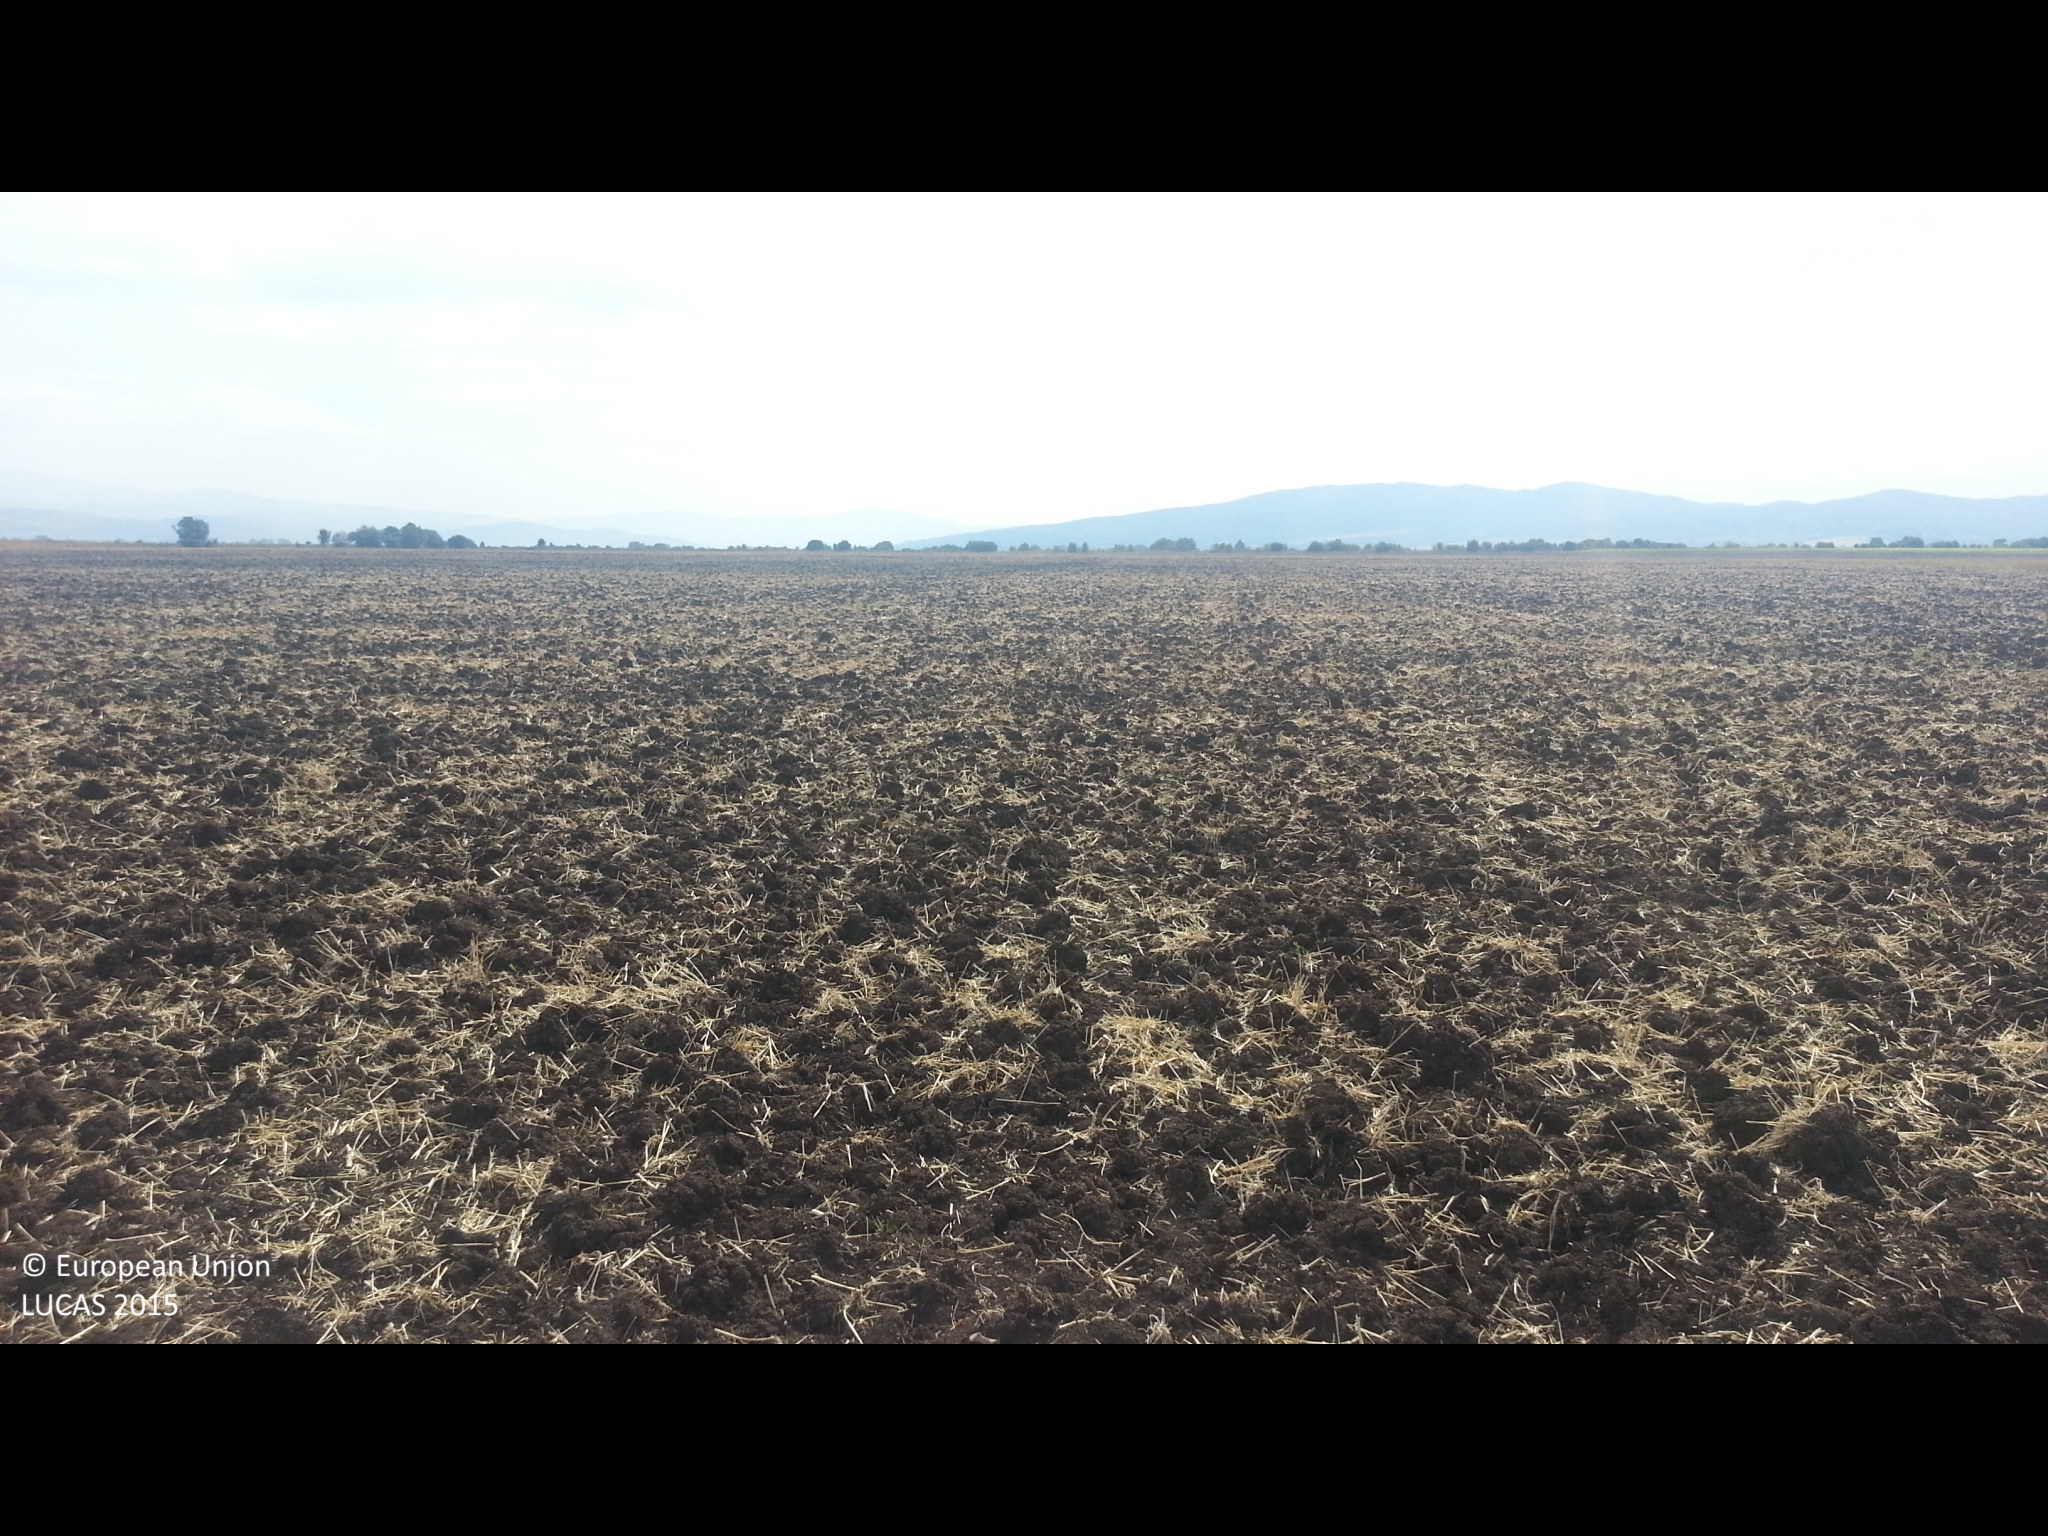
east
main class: Cropland
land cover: Common wheat
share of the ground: < 10 %
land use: Agriculture (excluding fallow land and kitchen gardens)
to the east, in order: Common wheat
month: August
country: BG
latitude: 42.4461
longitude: 22.9014
